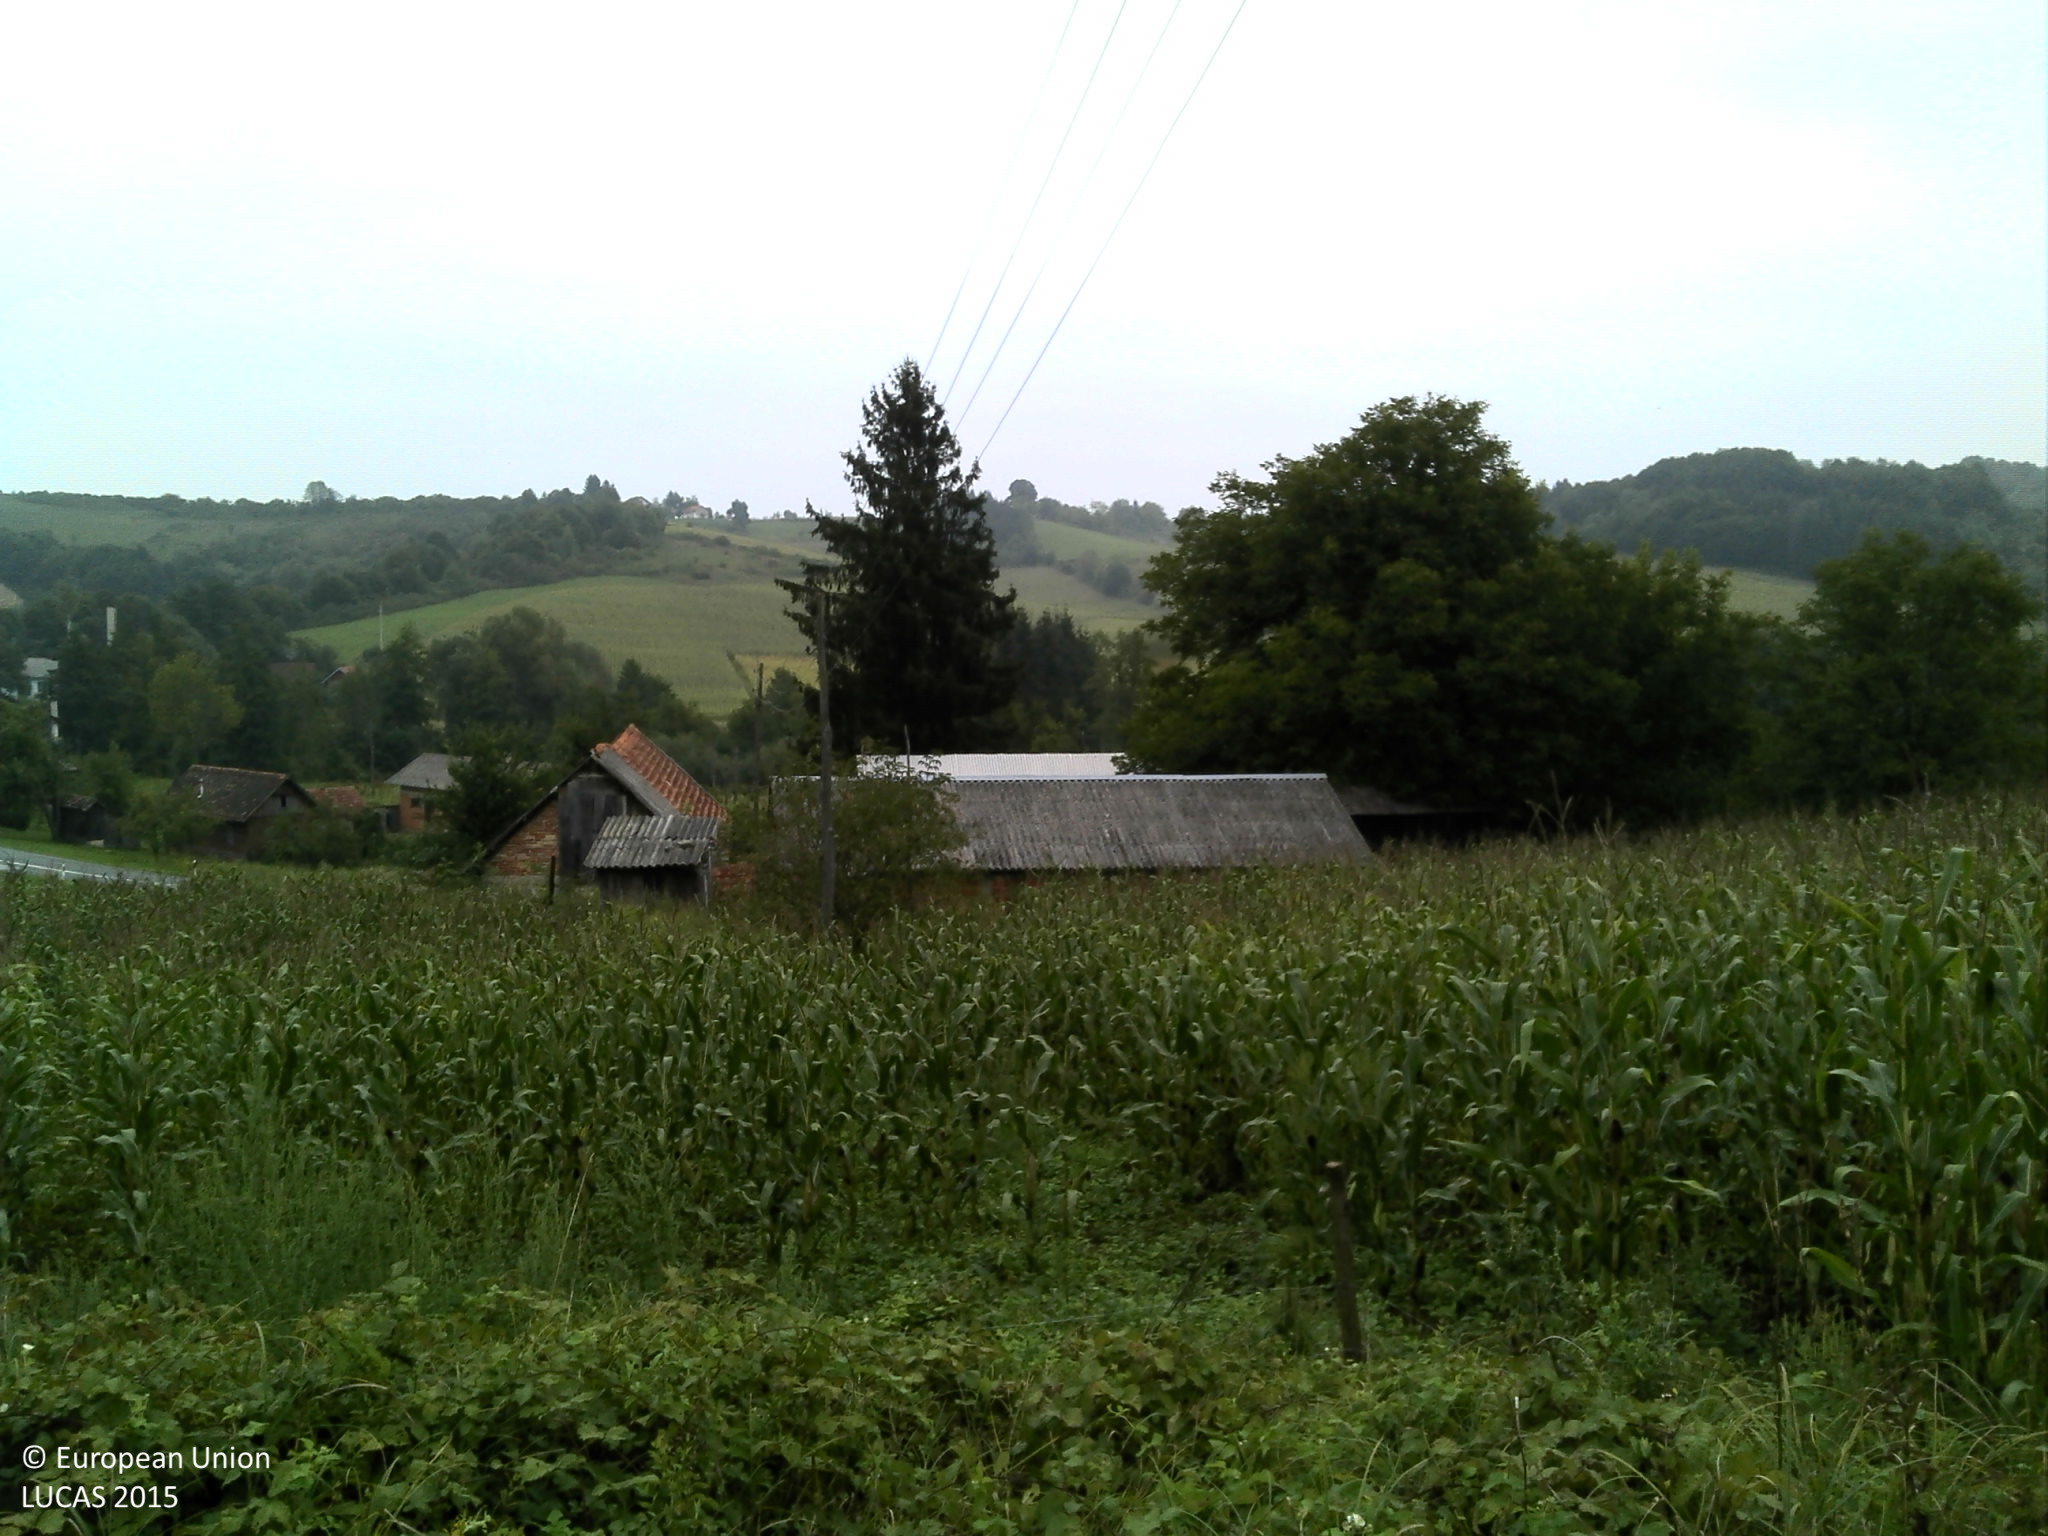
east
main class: Grassland
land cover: Spontaneously vegetated surfaces
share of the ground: > 75 %
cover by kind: herbaceous plants 100 %
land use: Semi-natural and natural areas not in use
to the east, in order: Spontaneously vegetated surfaces; Maize; Electric lines; Artificial constructions in urban areas; Grassland with sparse tree/shrub cover; Rivers and streams; Inland marshes
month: August
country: HR
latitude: 45.2978
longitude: 15.6706
